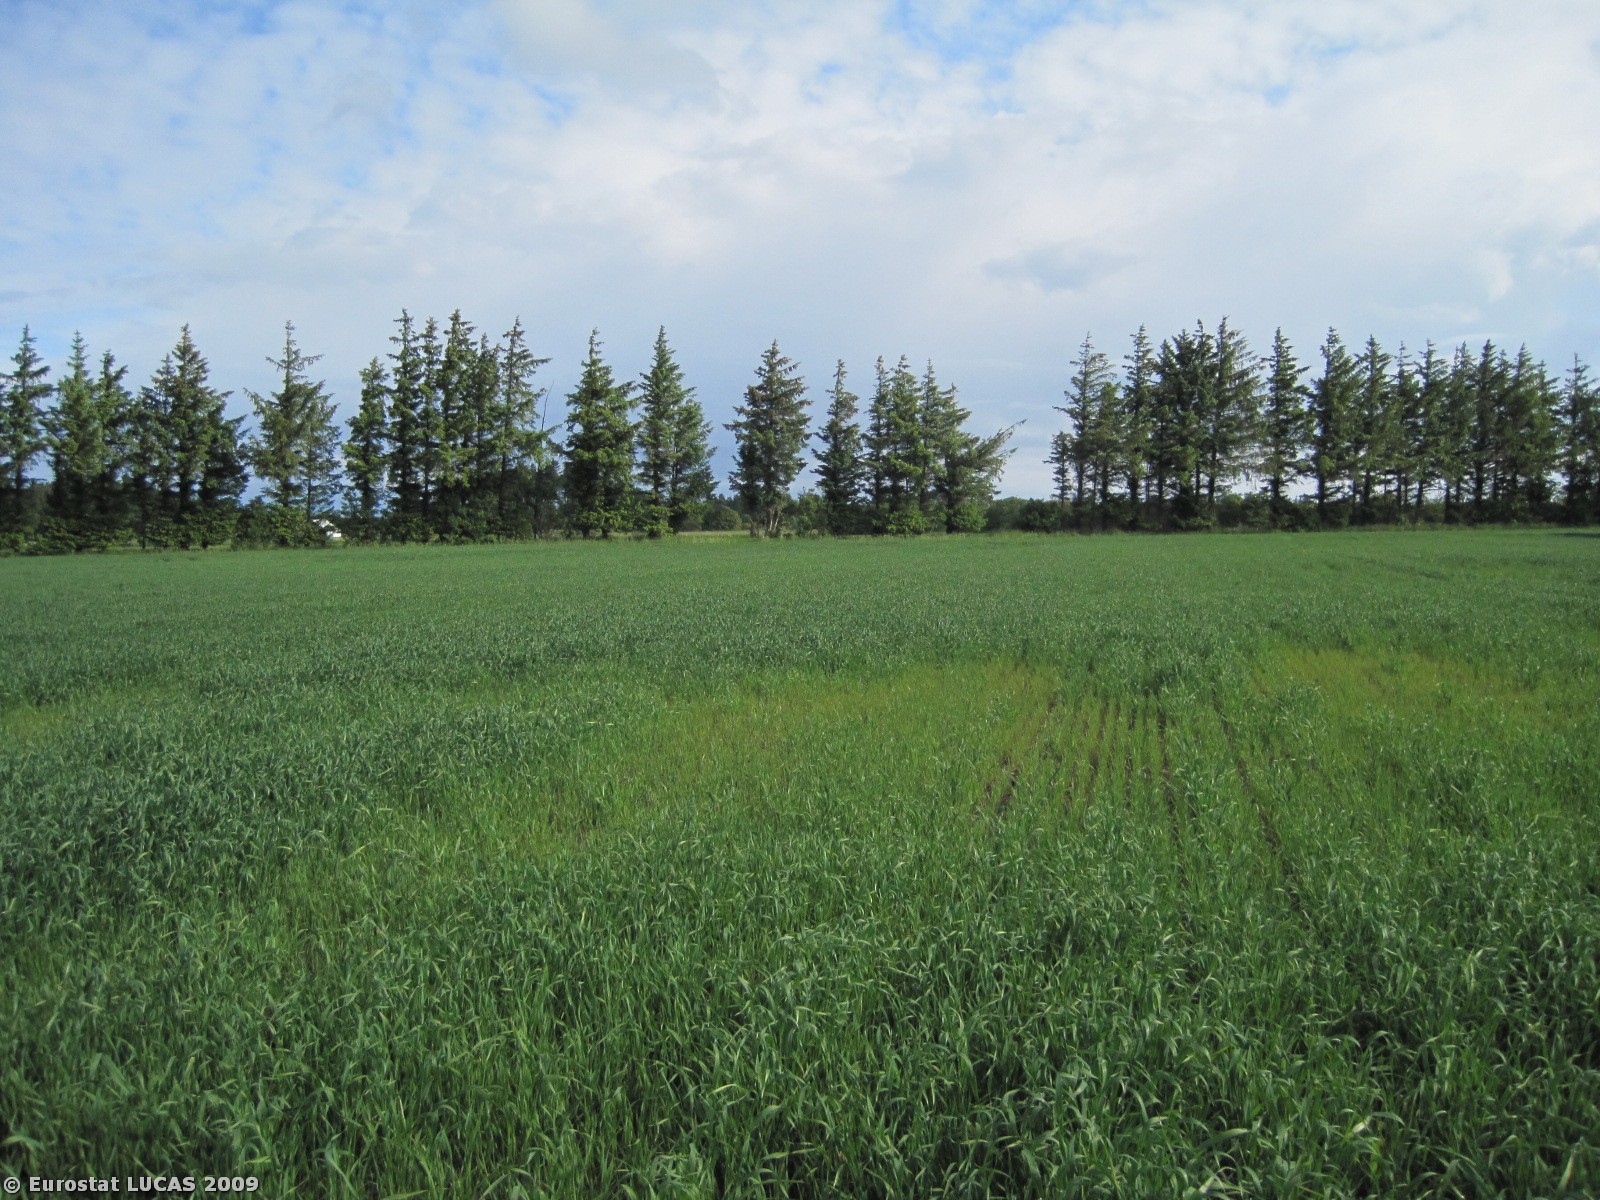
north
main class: Cropland
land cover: Common wheat
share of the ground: > 75 %
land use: Agriculture (excluding fallow land and kitchen gardens)
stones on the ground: < 10 %
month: June
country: DK
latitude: 57.5540
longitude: 10.0834
